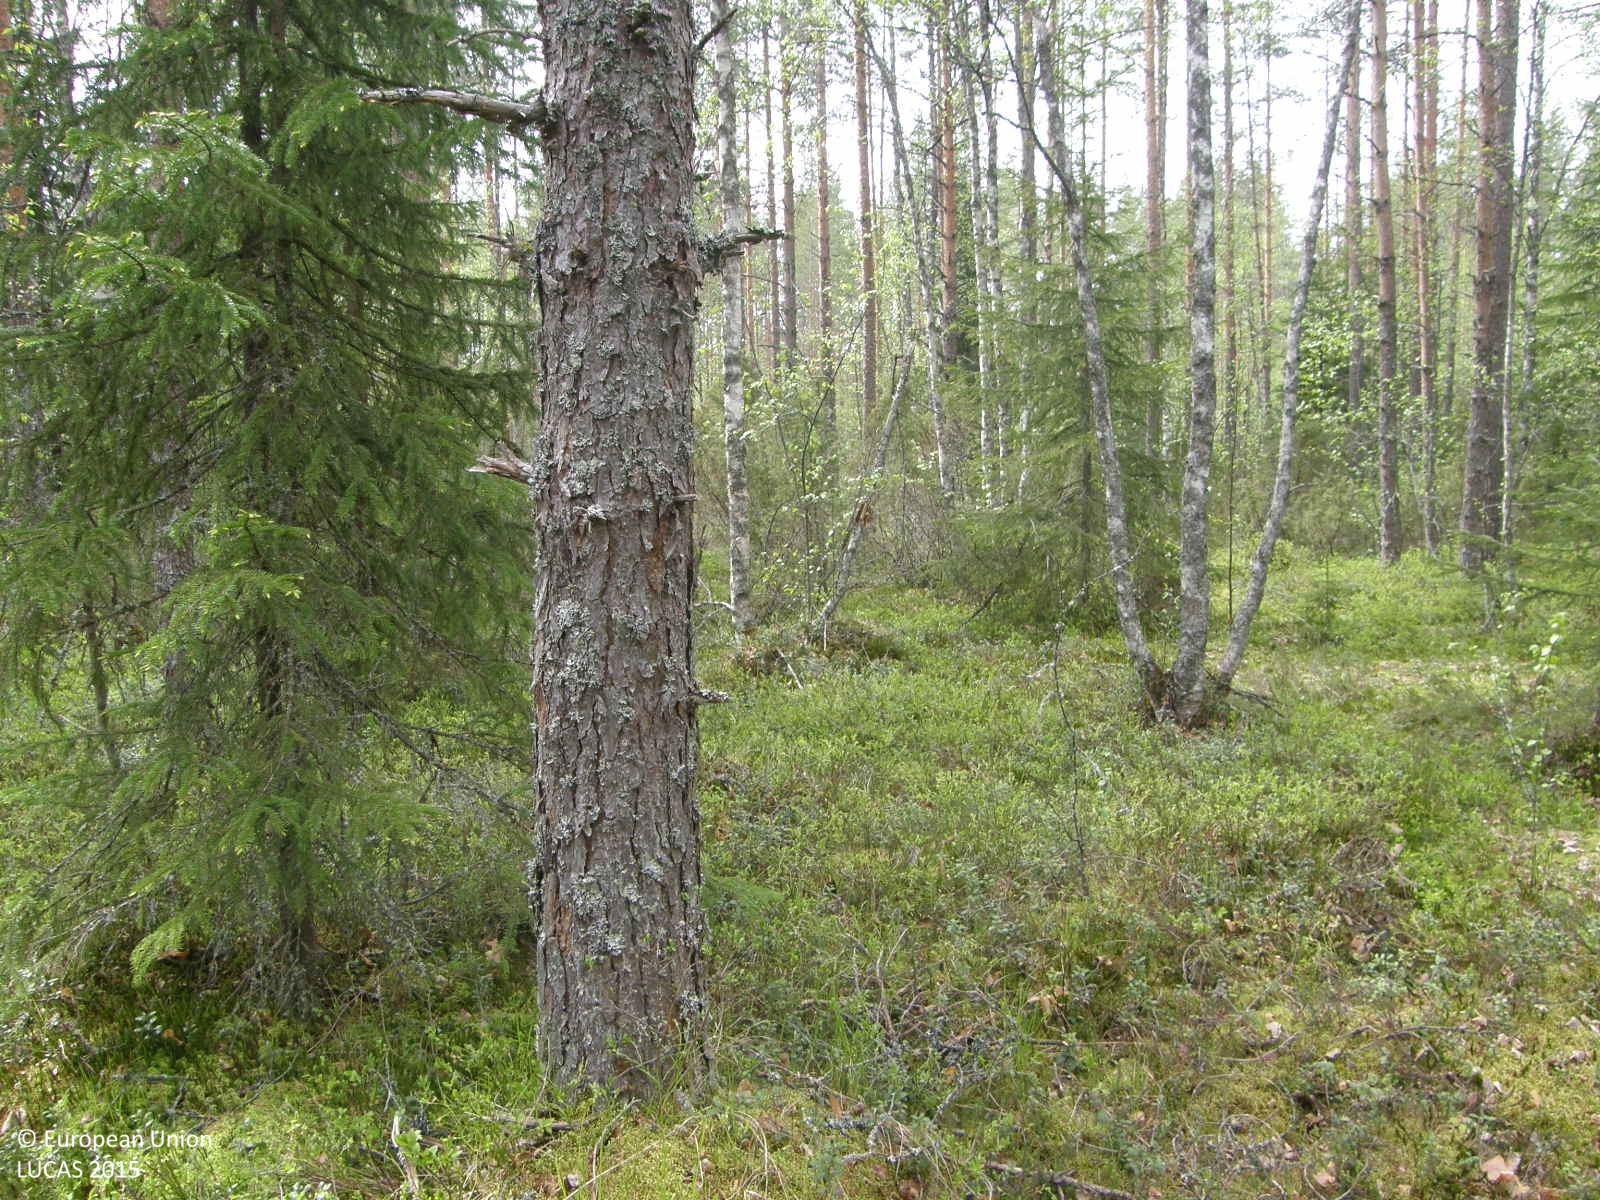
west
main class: Woodland
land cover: Pine dominated mixed woodland
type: boreal forest
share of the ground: > 75 %
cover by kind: coniferous forest trees 65 %, broadleaved forest trees 25 %, shrubs 10 %
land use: Forestry
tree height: > 5 m
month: June
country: FI
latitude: 62.1028
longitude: 22.3371
